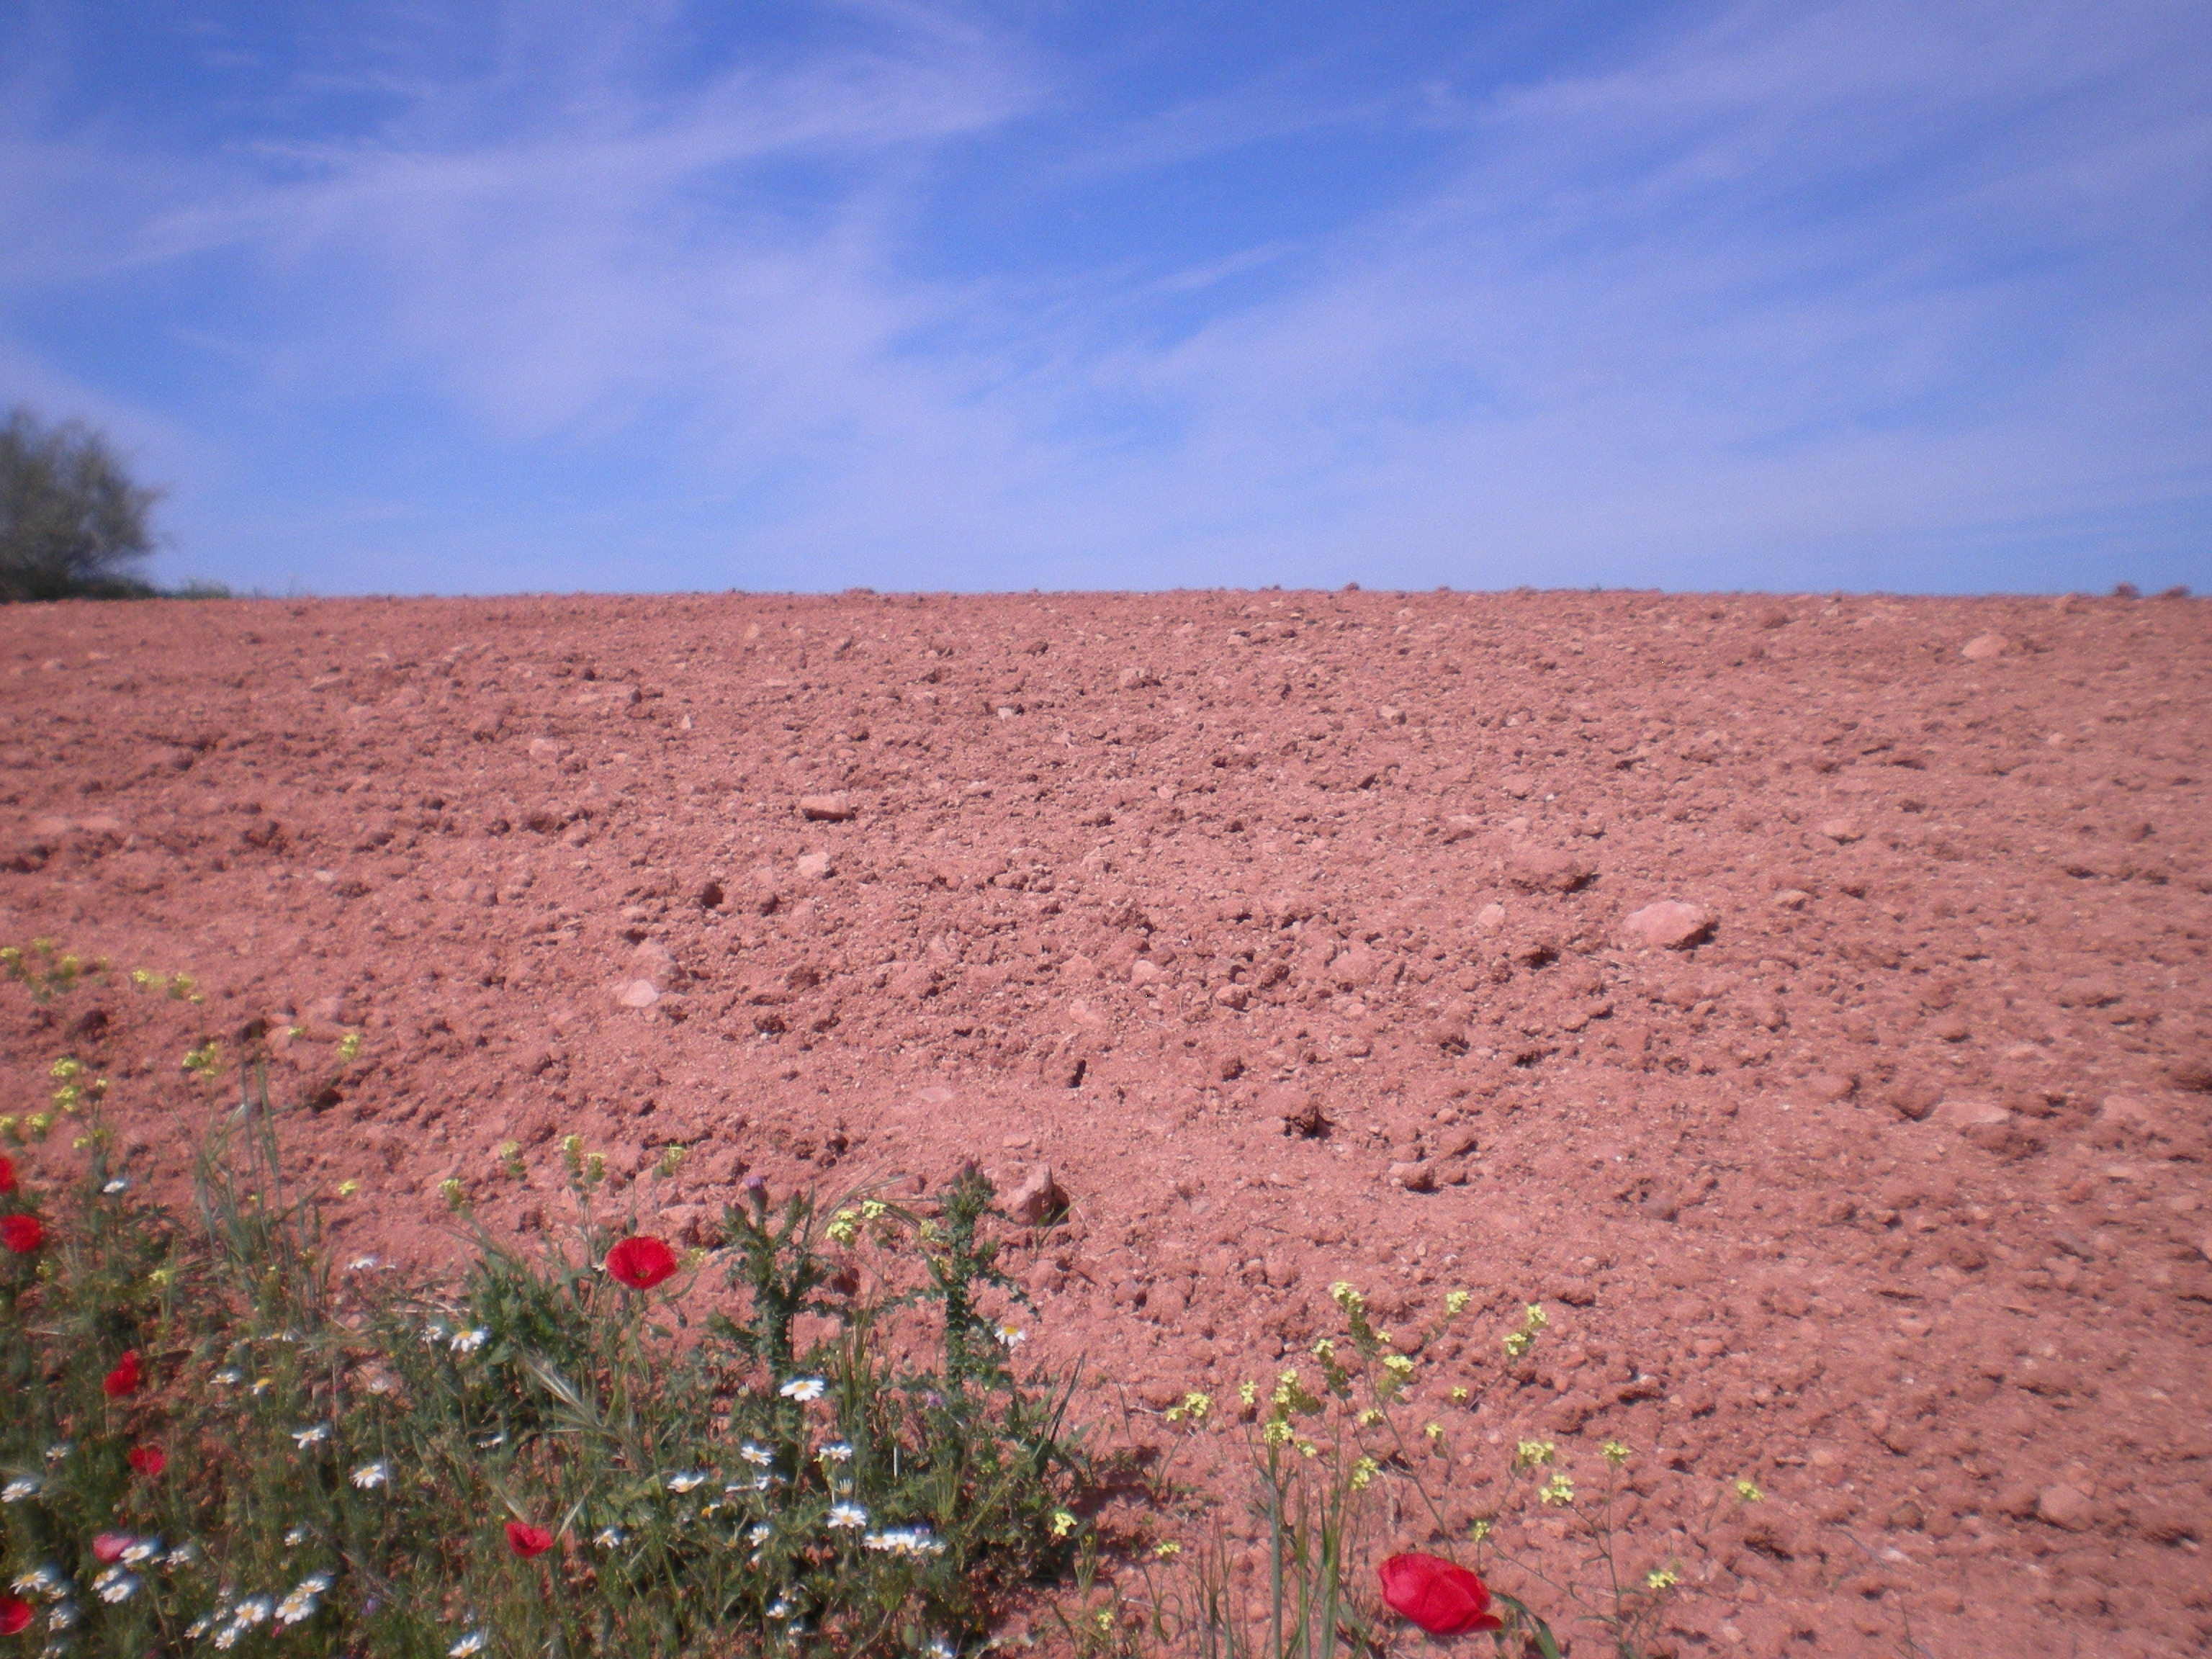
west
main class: Grassland
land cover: Grassland without tree/shrub cover
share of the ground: > 75 %
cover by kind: herbaceous plants 95 %, unconsolidated bare surface 5 %
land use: Semi-natural and natural areas not in use
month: April
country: ES
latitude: 38.6088
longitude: -3.0161
